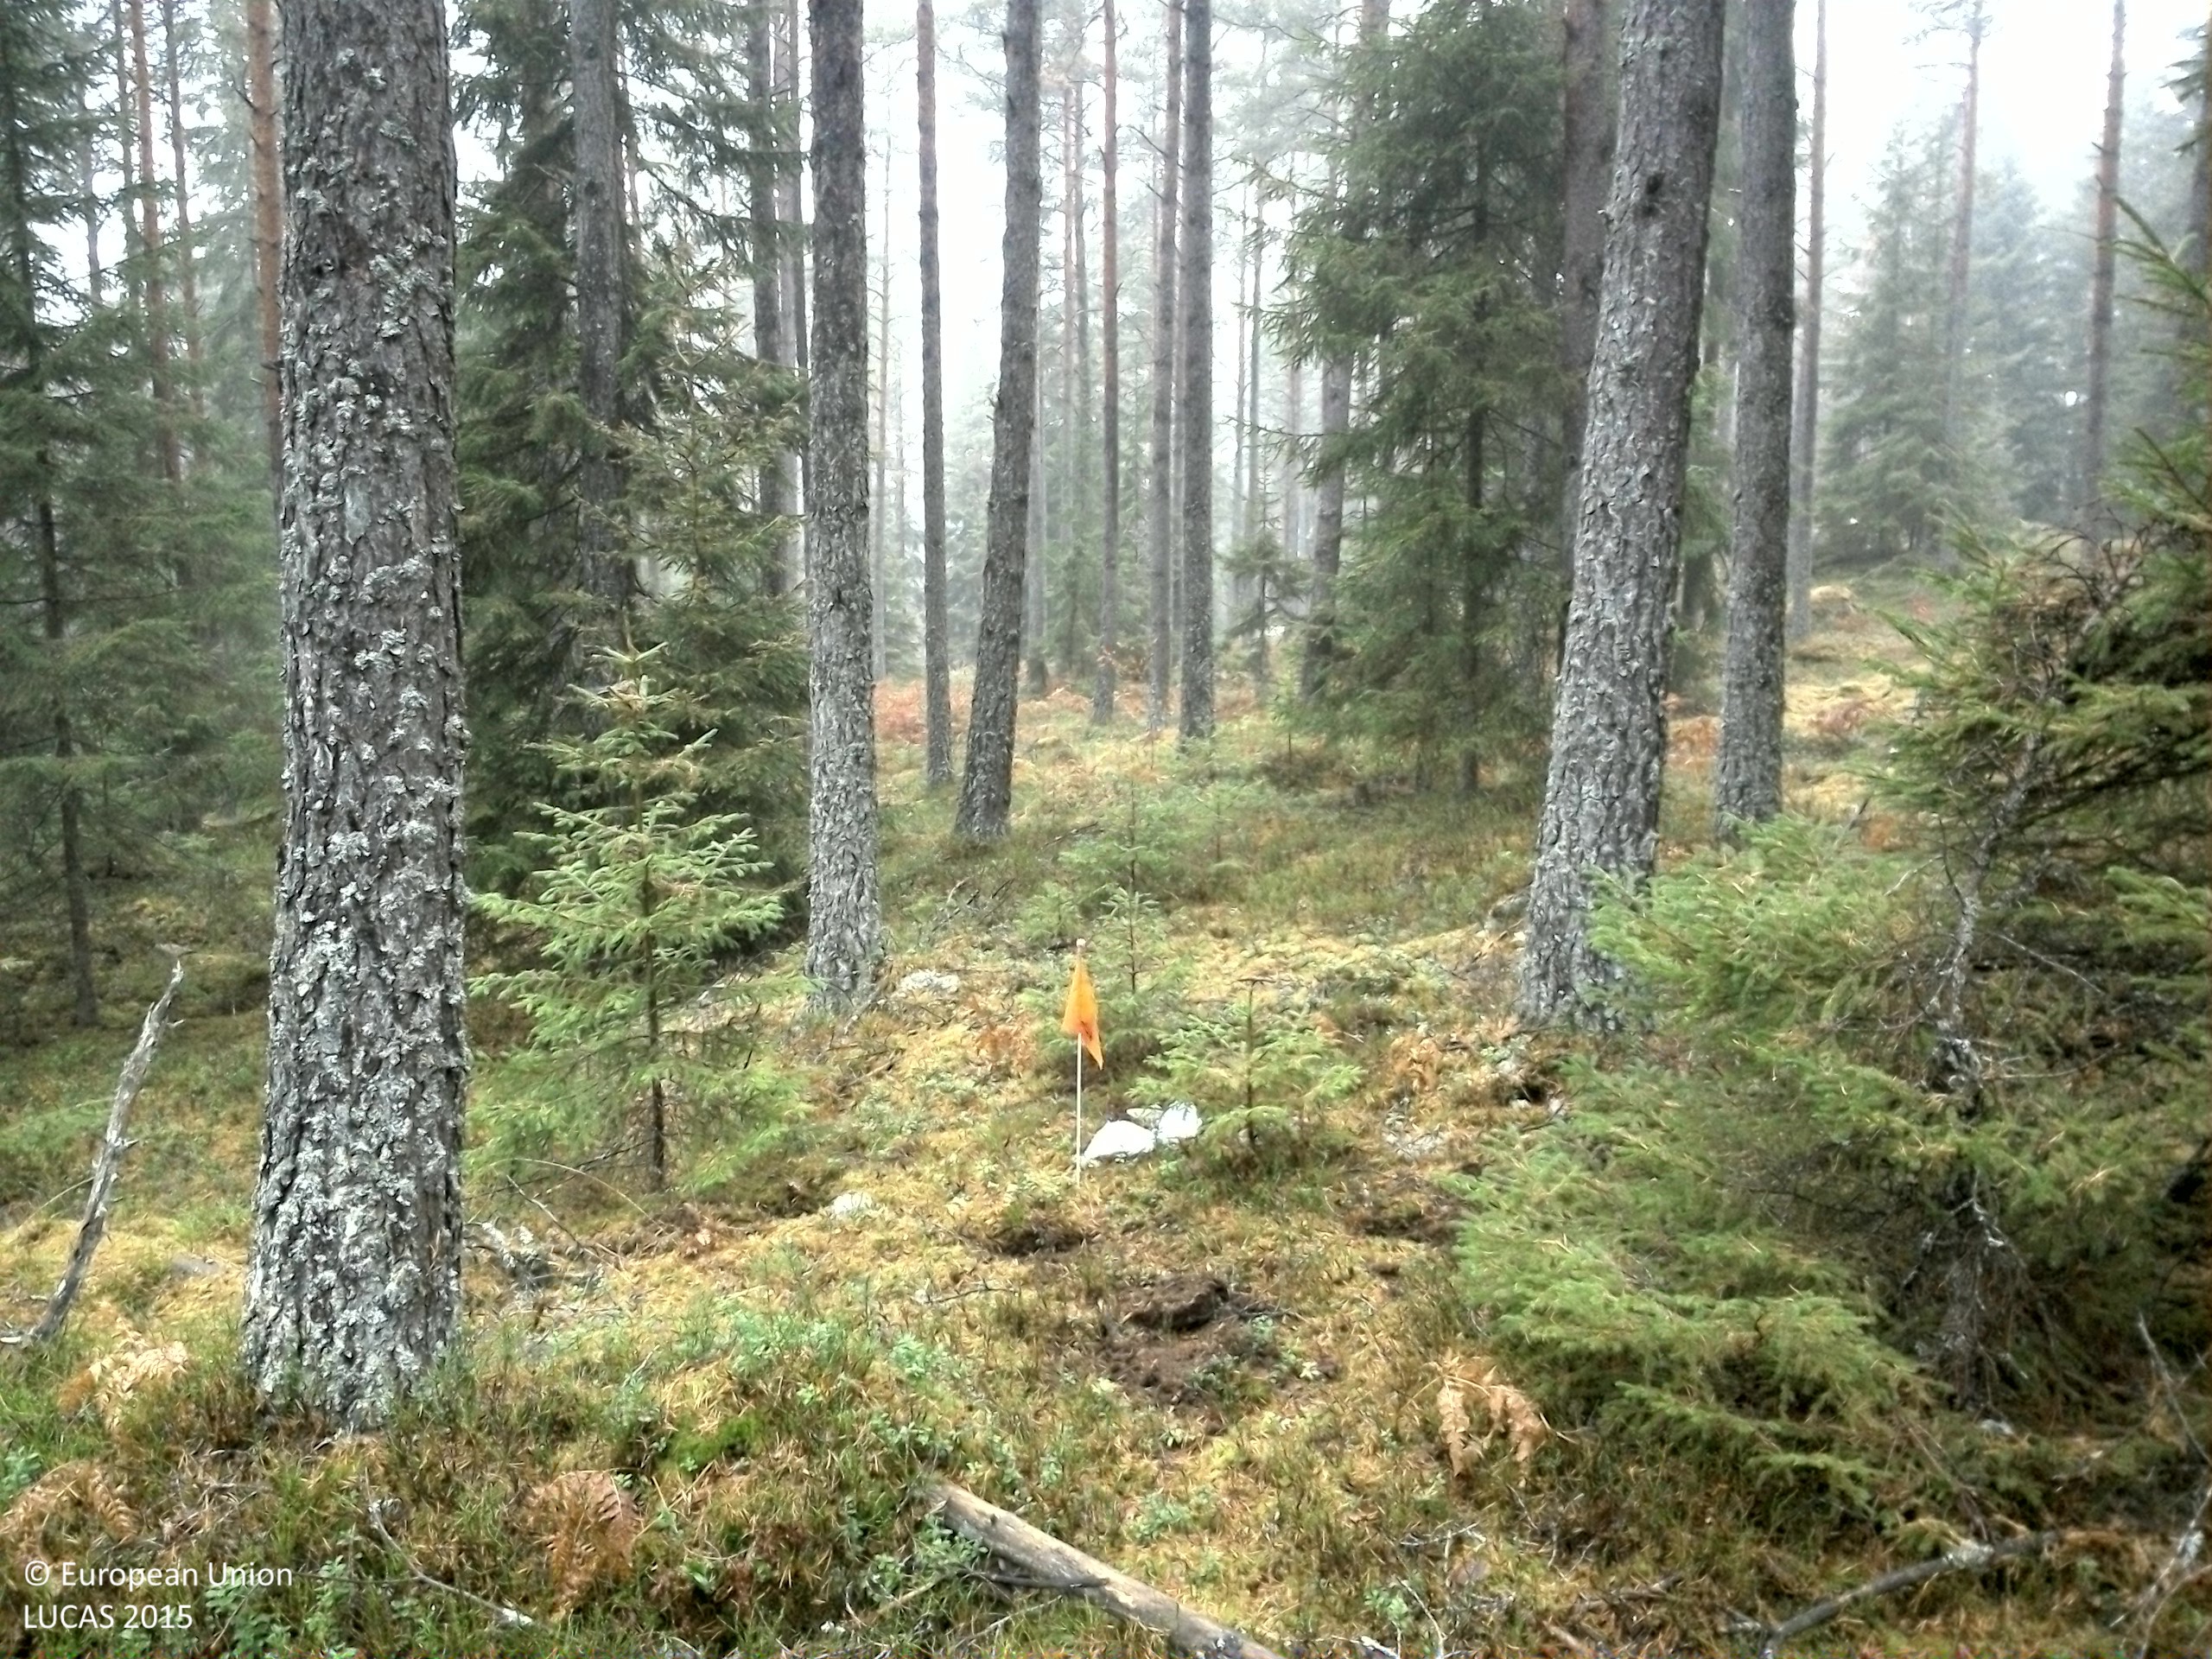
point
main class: Woodland
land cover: Pine dominated coniferous woodland
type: boreal forest
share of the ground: 50 - 75 %
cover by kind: coniferous forest trees 70 %, shrubs 15 %, lichens and mosses 15 %
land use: Forestry
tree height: > 5 m
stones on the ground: < 10 %
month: November
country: SE
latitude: 57.6948
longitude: 14.9783
